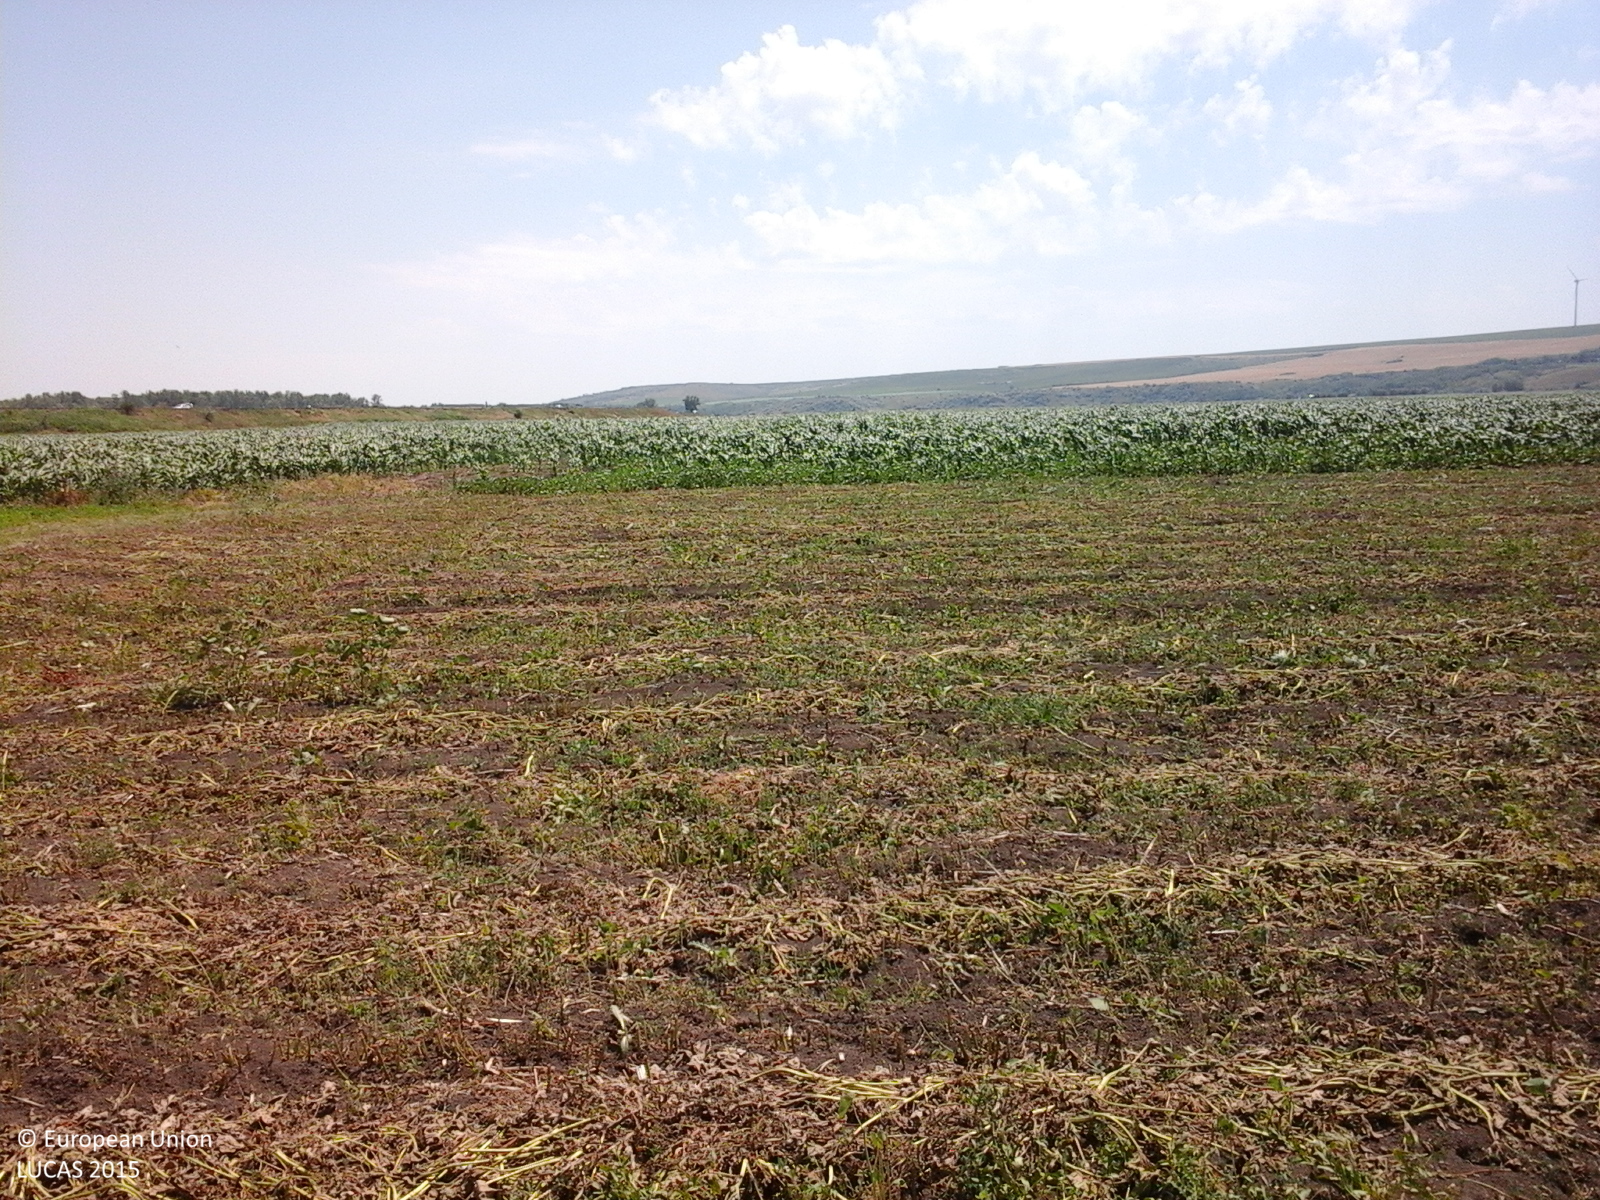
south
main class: Cropland
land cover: Lucerne
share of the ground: > 75 %
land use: Agriculture (excluding fallow land and kitchen gardens)
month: June
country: RO
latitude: 46.8359
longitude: 28.1080
